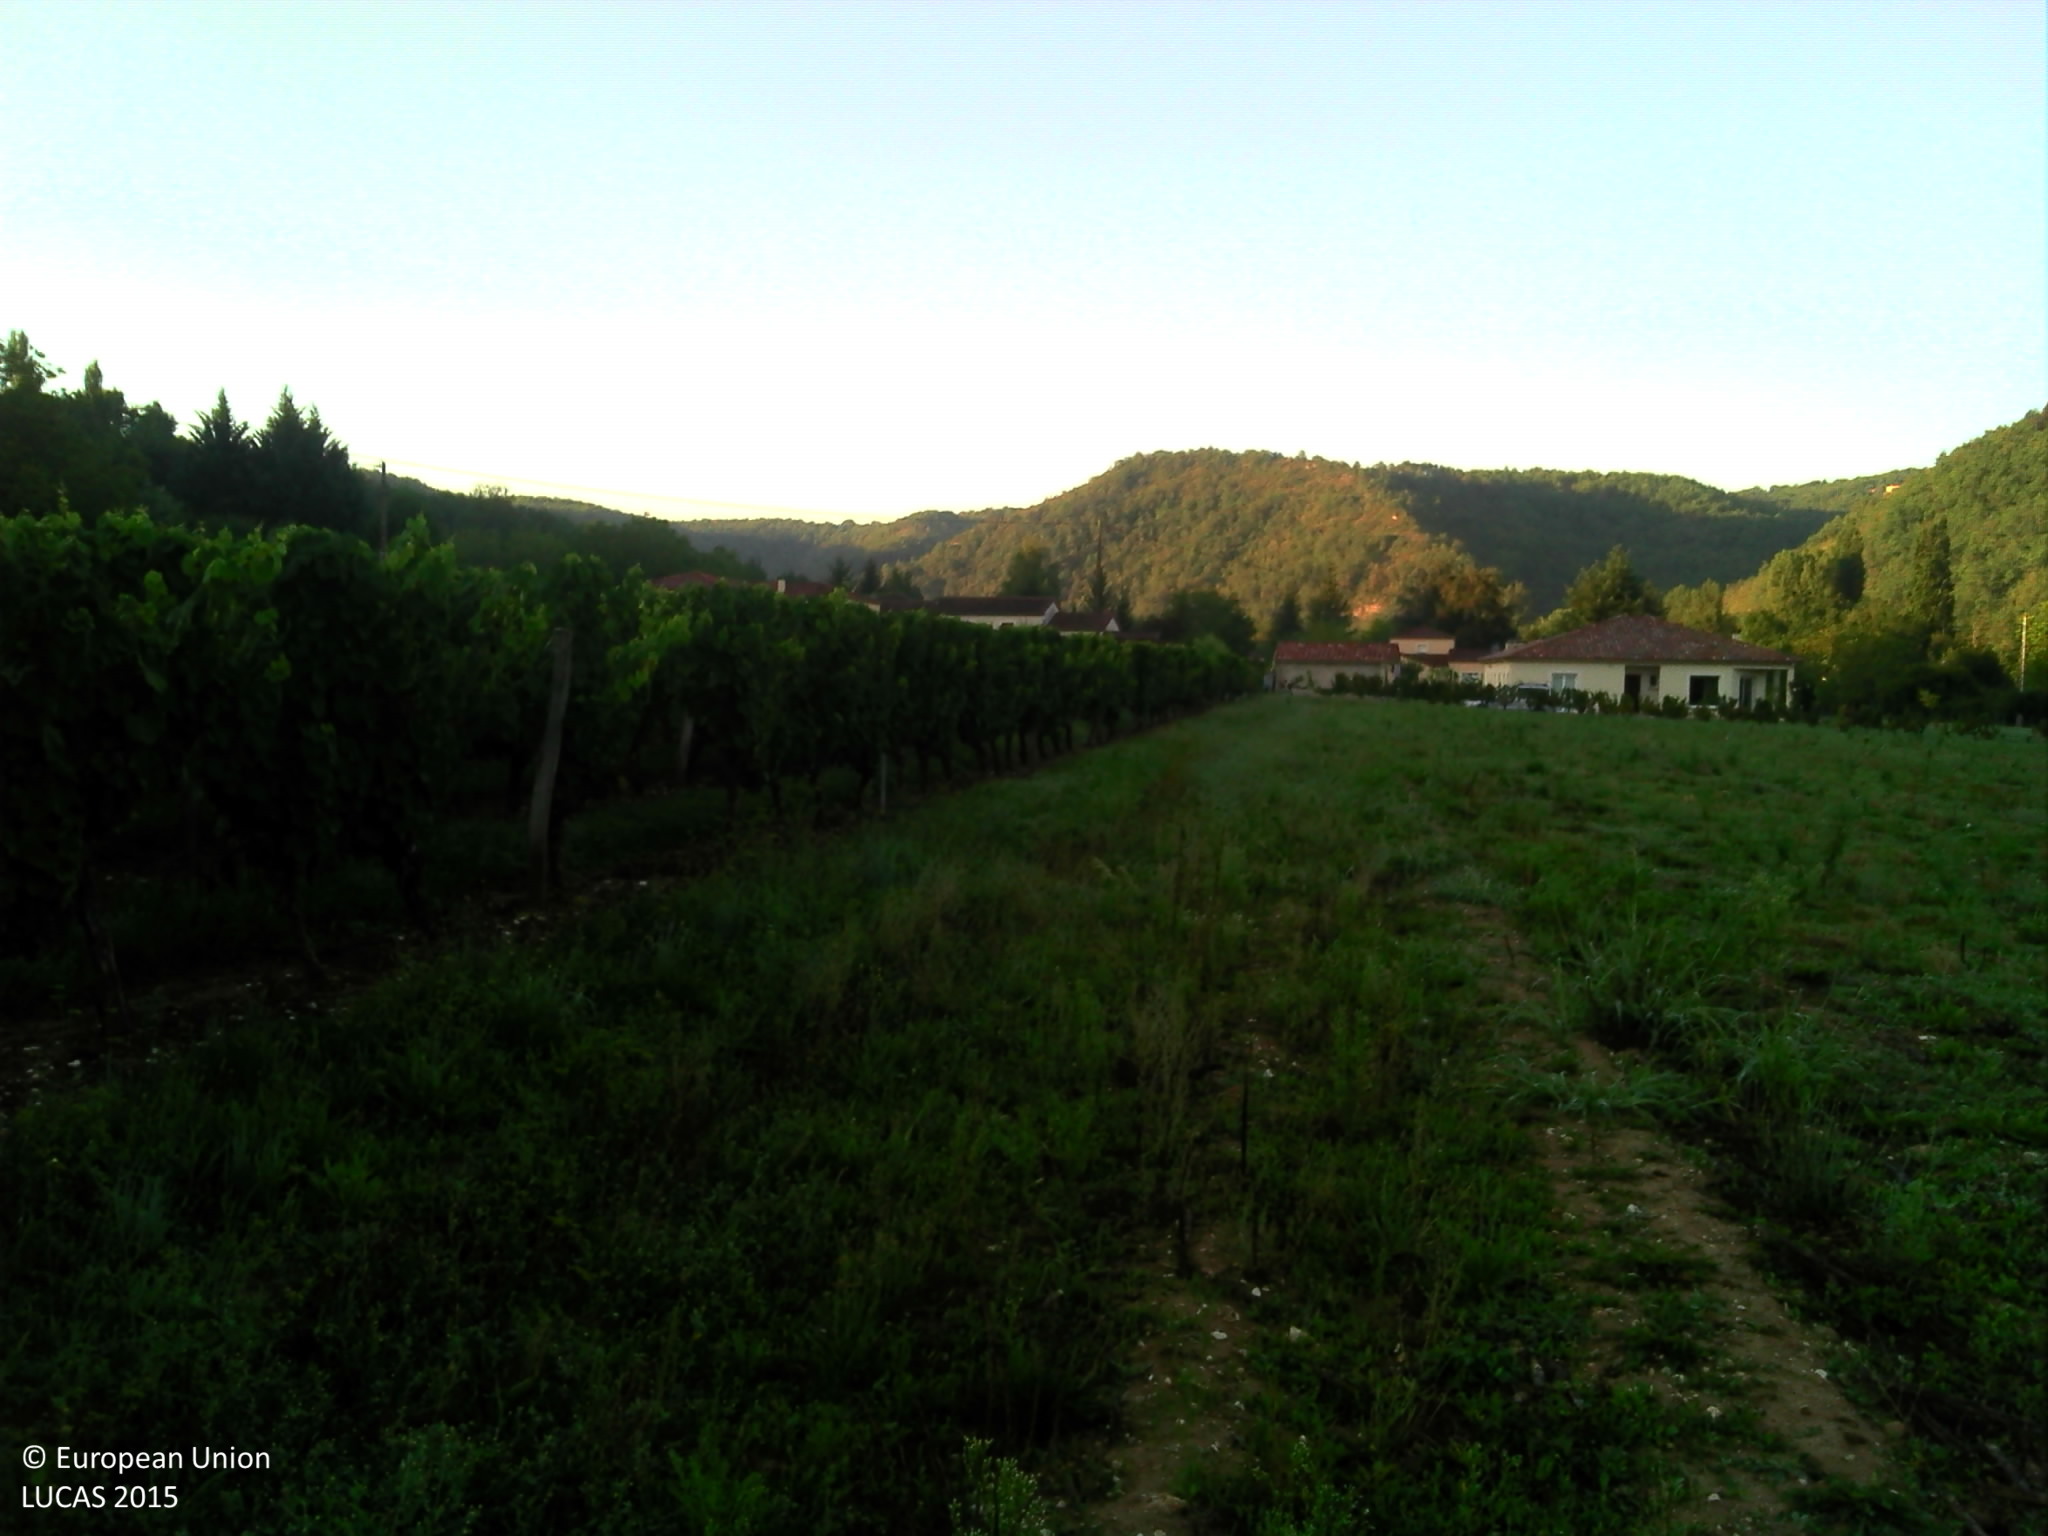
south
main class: Grassland
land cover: Grassland without tree/shrub cover
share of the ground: > 75 %
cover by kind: herbaceous plants 100 %
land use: Agriculture (excluding fallow land and kitchen gardens)
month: August
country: FR
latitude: 44.4729
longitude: 1.2854
